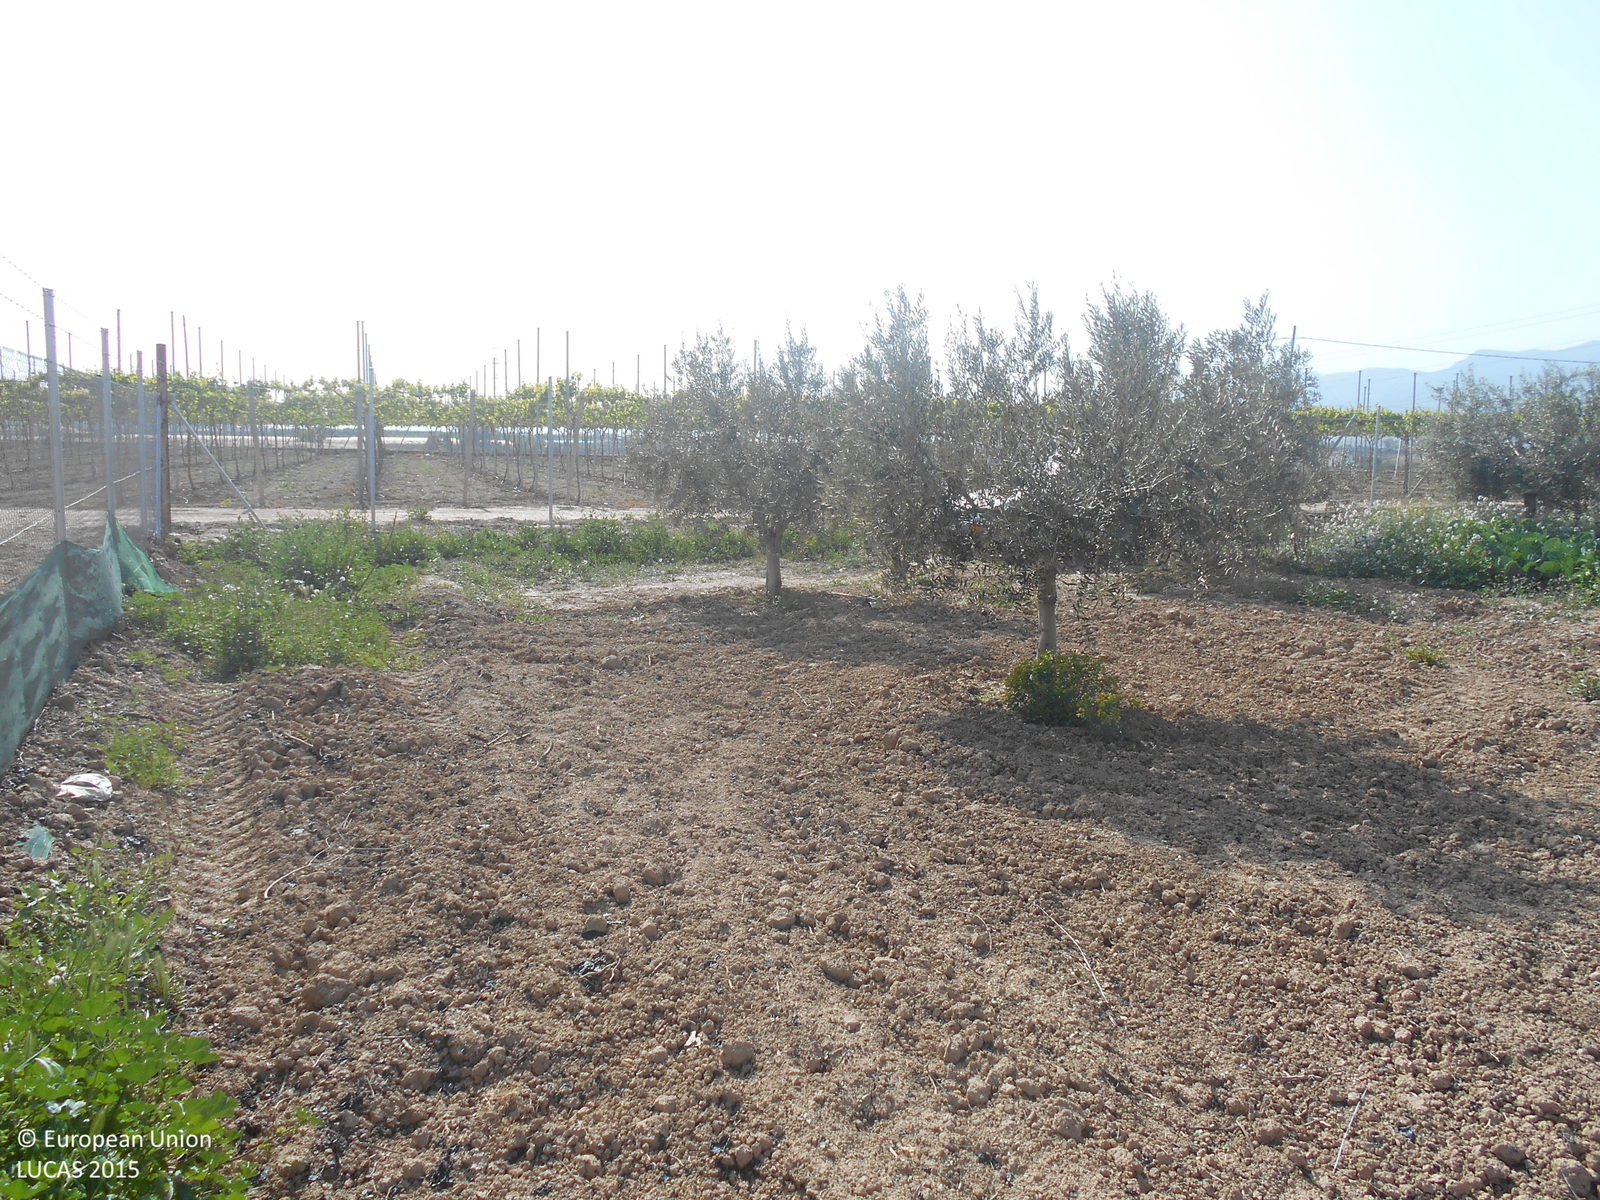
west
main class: Cropland
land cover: Vineyards
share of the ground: 25 - 50 %
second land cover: Other bare soil
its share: > 75 %
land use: Agriculture (excluding fallow land and kitchen gardens)
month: April
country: ES
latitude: 37.7041
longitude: -1.5174
